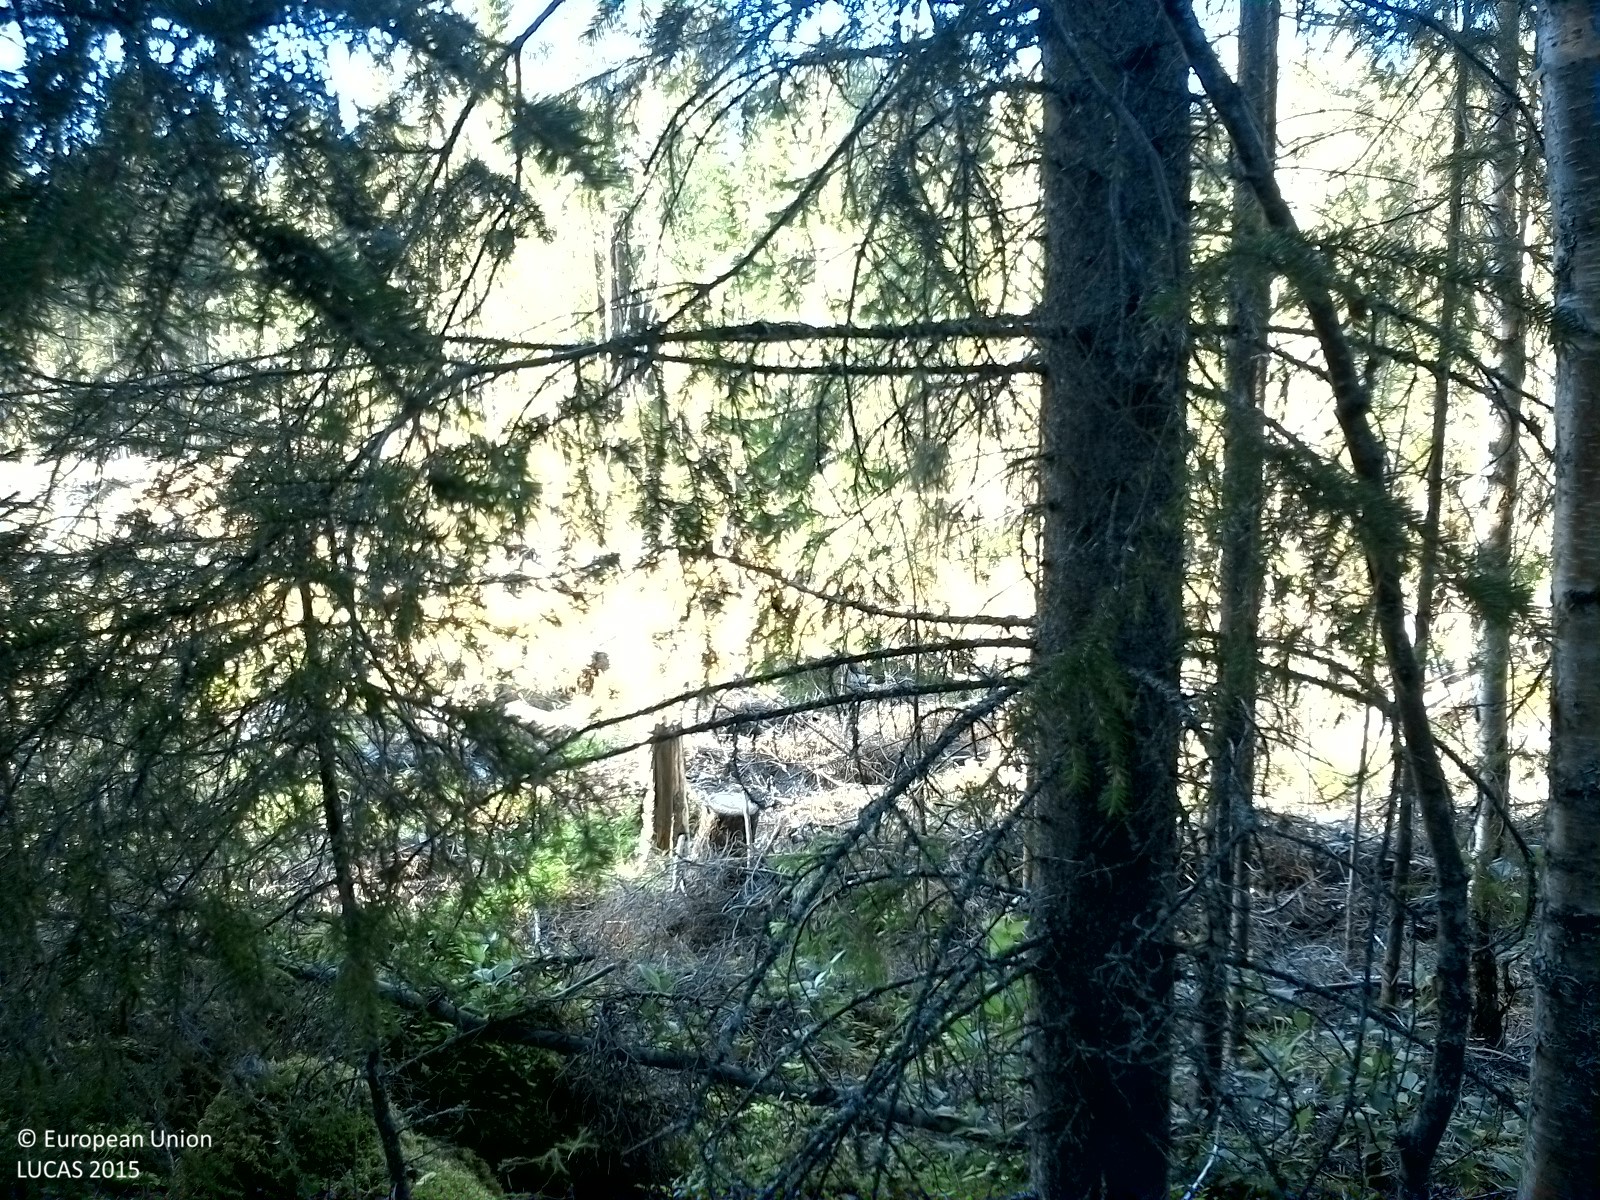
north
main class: Woodland
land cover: Spruce dominated mixed woodland
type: boreal forest
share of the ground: > 75 %
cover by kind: broadleaved forest trees 40 %, coniferous forest trees 35 %, lichens and mosses 15 %, herbaceous plants 10 %
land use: Forestry
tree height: > 5 m
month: August
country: SE
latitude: 62.3850
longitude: 16.4194
